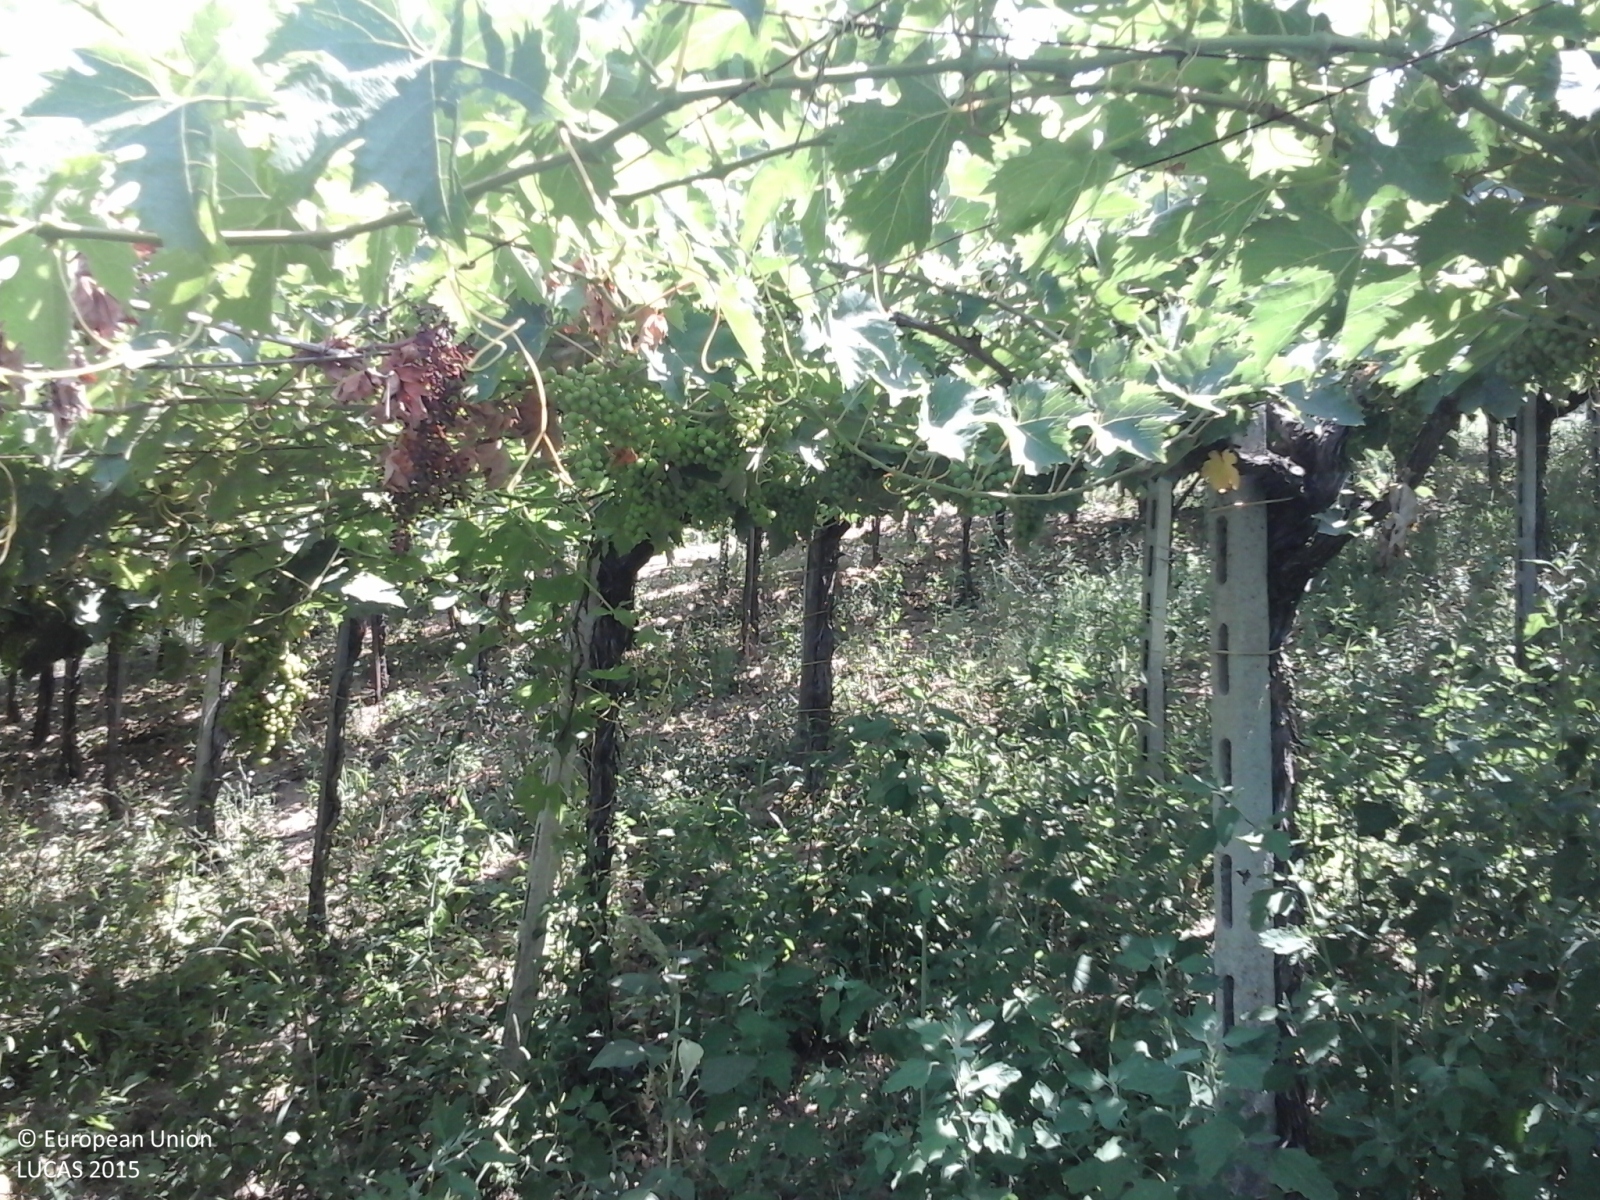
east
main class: Cropland
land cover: Vineyards
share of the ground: 25 - 50 %
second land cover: Spontaneously vegetated surfaces
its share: 25 - 50 %
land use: Agriculture (excluding fallow land and kitchen gardens)
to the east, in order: Vineyards; Spontaneously vegetated surfaces; Olive groves; Vineyards; Olive groves
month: July
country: IT
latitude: 42.3118
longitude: 14.2455
